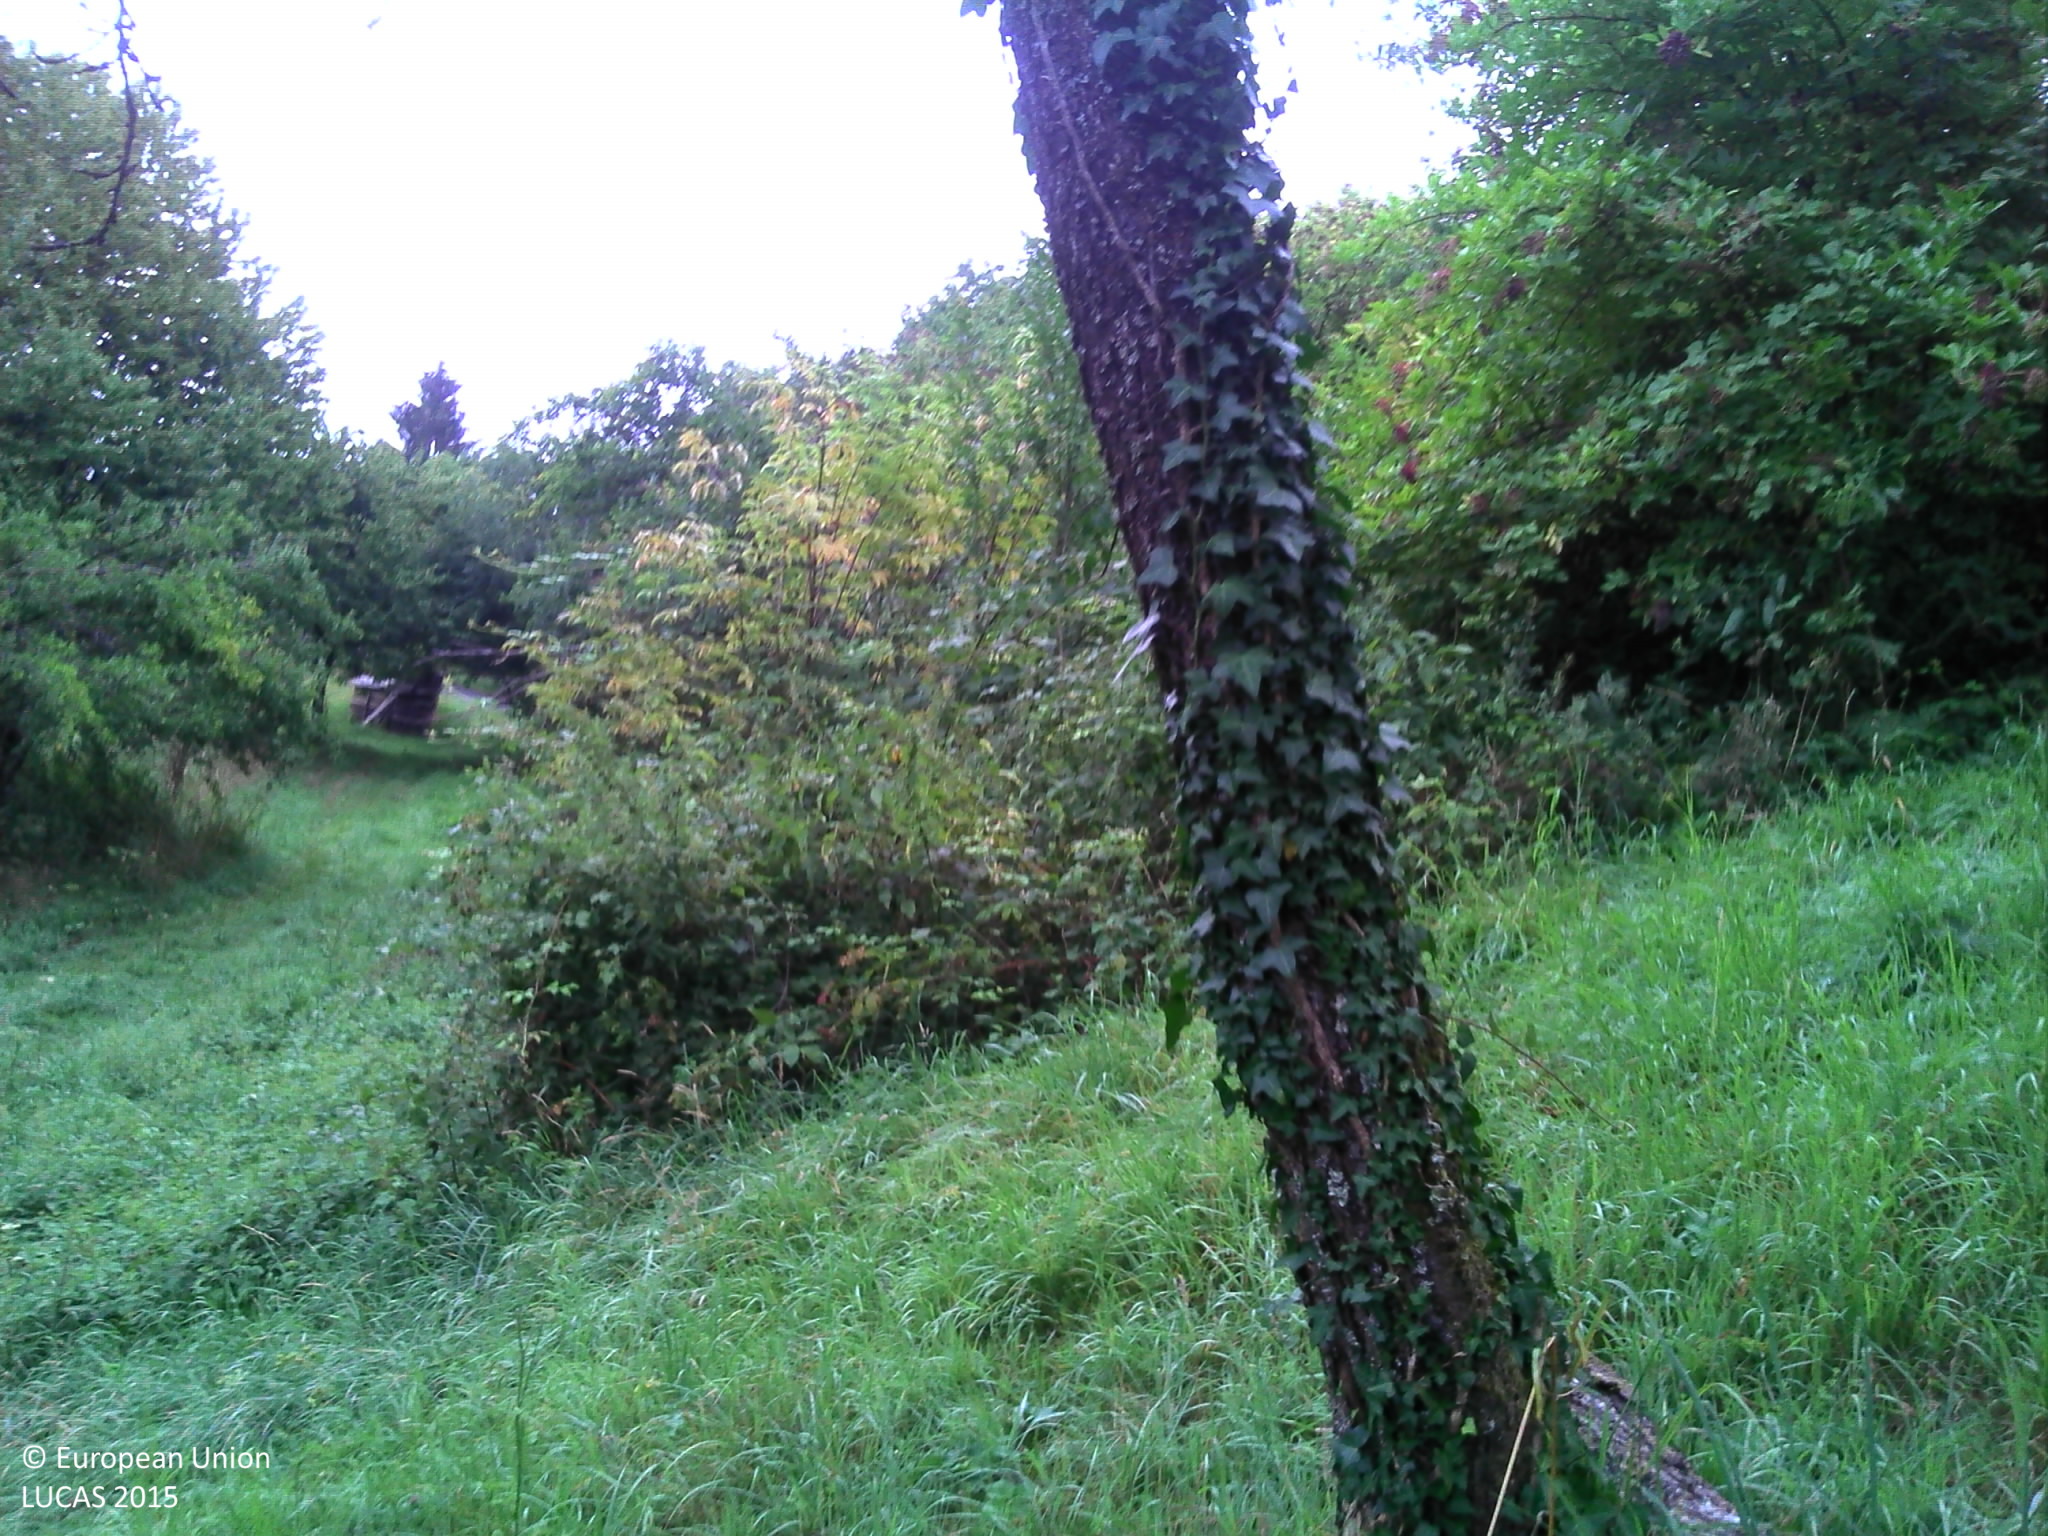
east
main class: Grassland
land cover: Grassland with sparse tree/shrub cover
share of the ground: > 75 %
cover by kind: herbaceous plants 95 %, broadleaved forest trees 5 %
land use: Agriculture (excluding fallow land and kitchen gardens)
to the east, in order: Grassland with sparse tree/shrub cover; Broadleaved woodland; Fences; Grassland without tree/shrub cover; Broadleaved woodland; Fences; Broadleaved woodland; Artificial constructions in urban areas
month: August
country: FR
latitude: 48.9109
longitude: 7.3126
